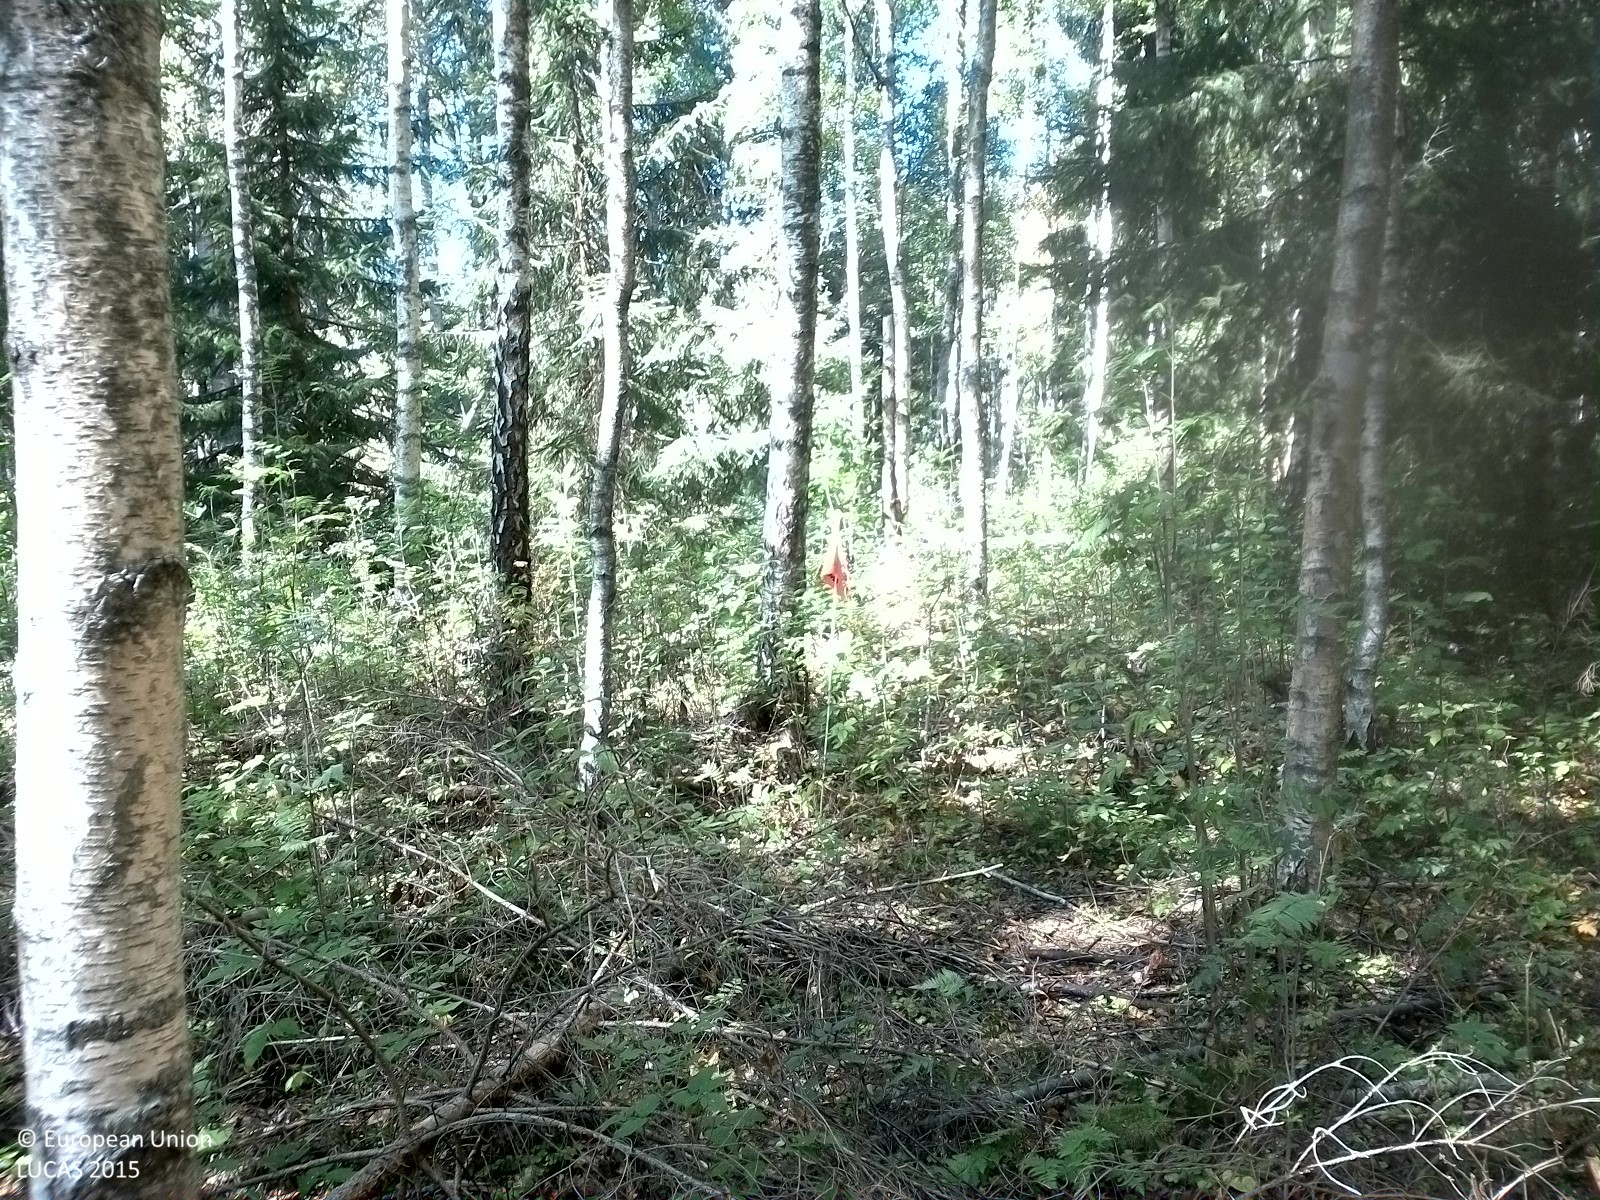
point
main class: Woodland
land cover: Spruce dominated mixed woodland
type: boreal forest
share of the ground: 25 - 50 %
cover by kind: coniferous forest trees 25 %, herbaceous plants 25 %, broadleaved forest trees 20 %, unconsolidated bare surface 20 %, shrubs 5 %, lichens and mosses 5 %
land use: Forestry
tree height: > 5 m
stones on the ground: < 10 %
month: August
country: SE
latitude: 59.2428
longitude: 15.5142
